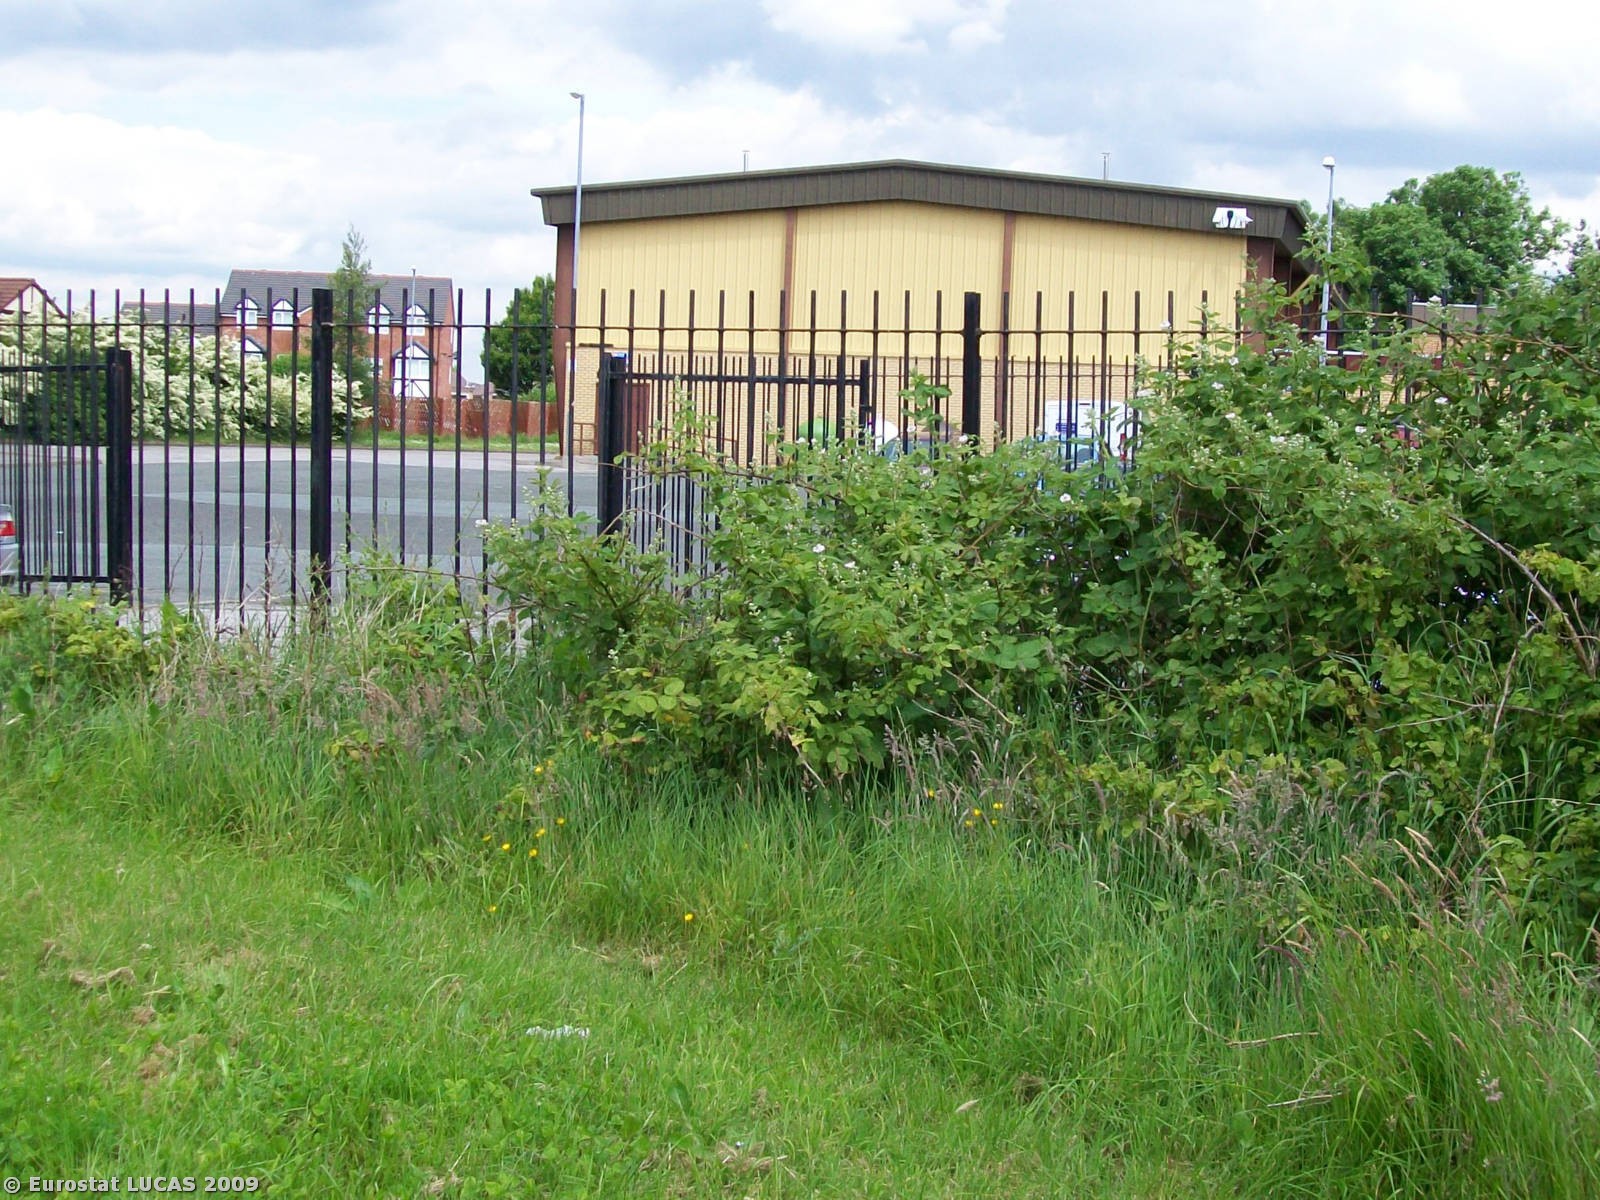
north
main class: Grassland
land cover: Grassland without tree/shrub cover
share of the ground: < 10 %
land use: Amenities, museums, leisure
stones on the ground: < 10 %
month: June
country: GB
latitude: 53.3777
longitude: -2.7725
